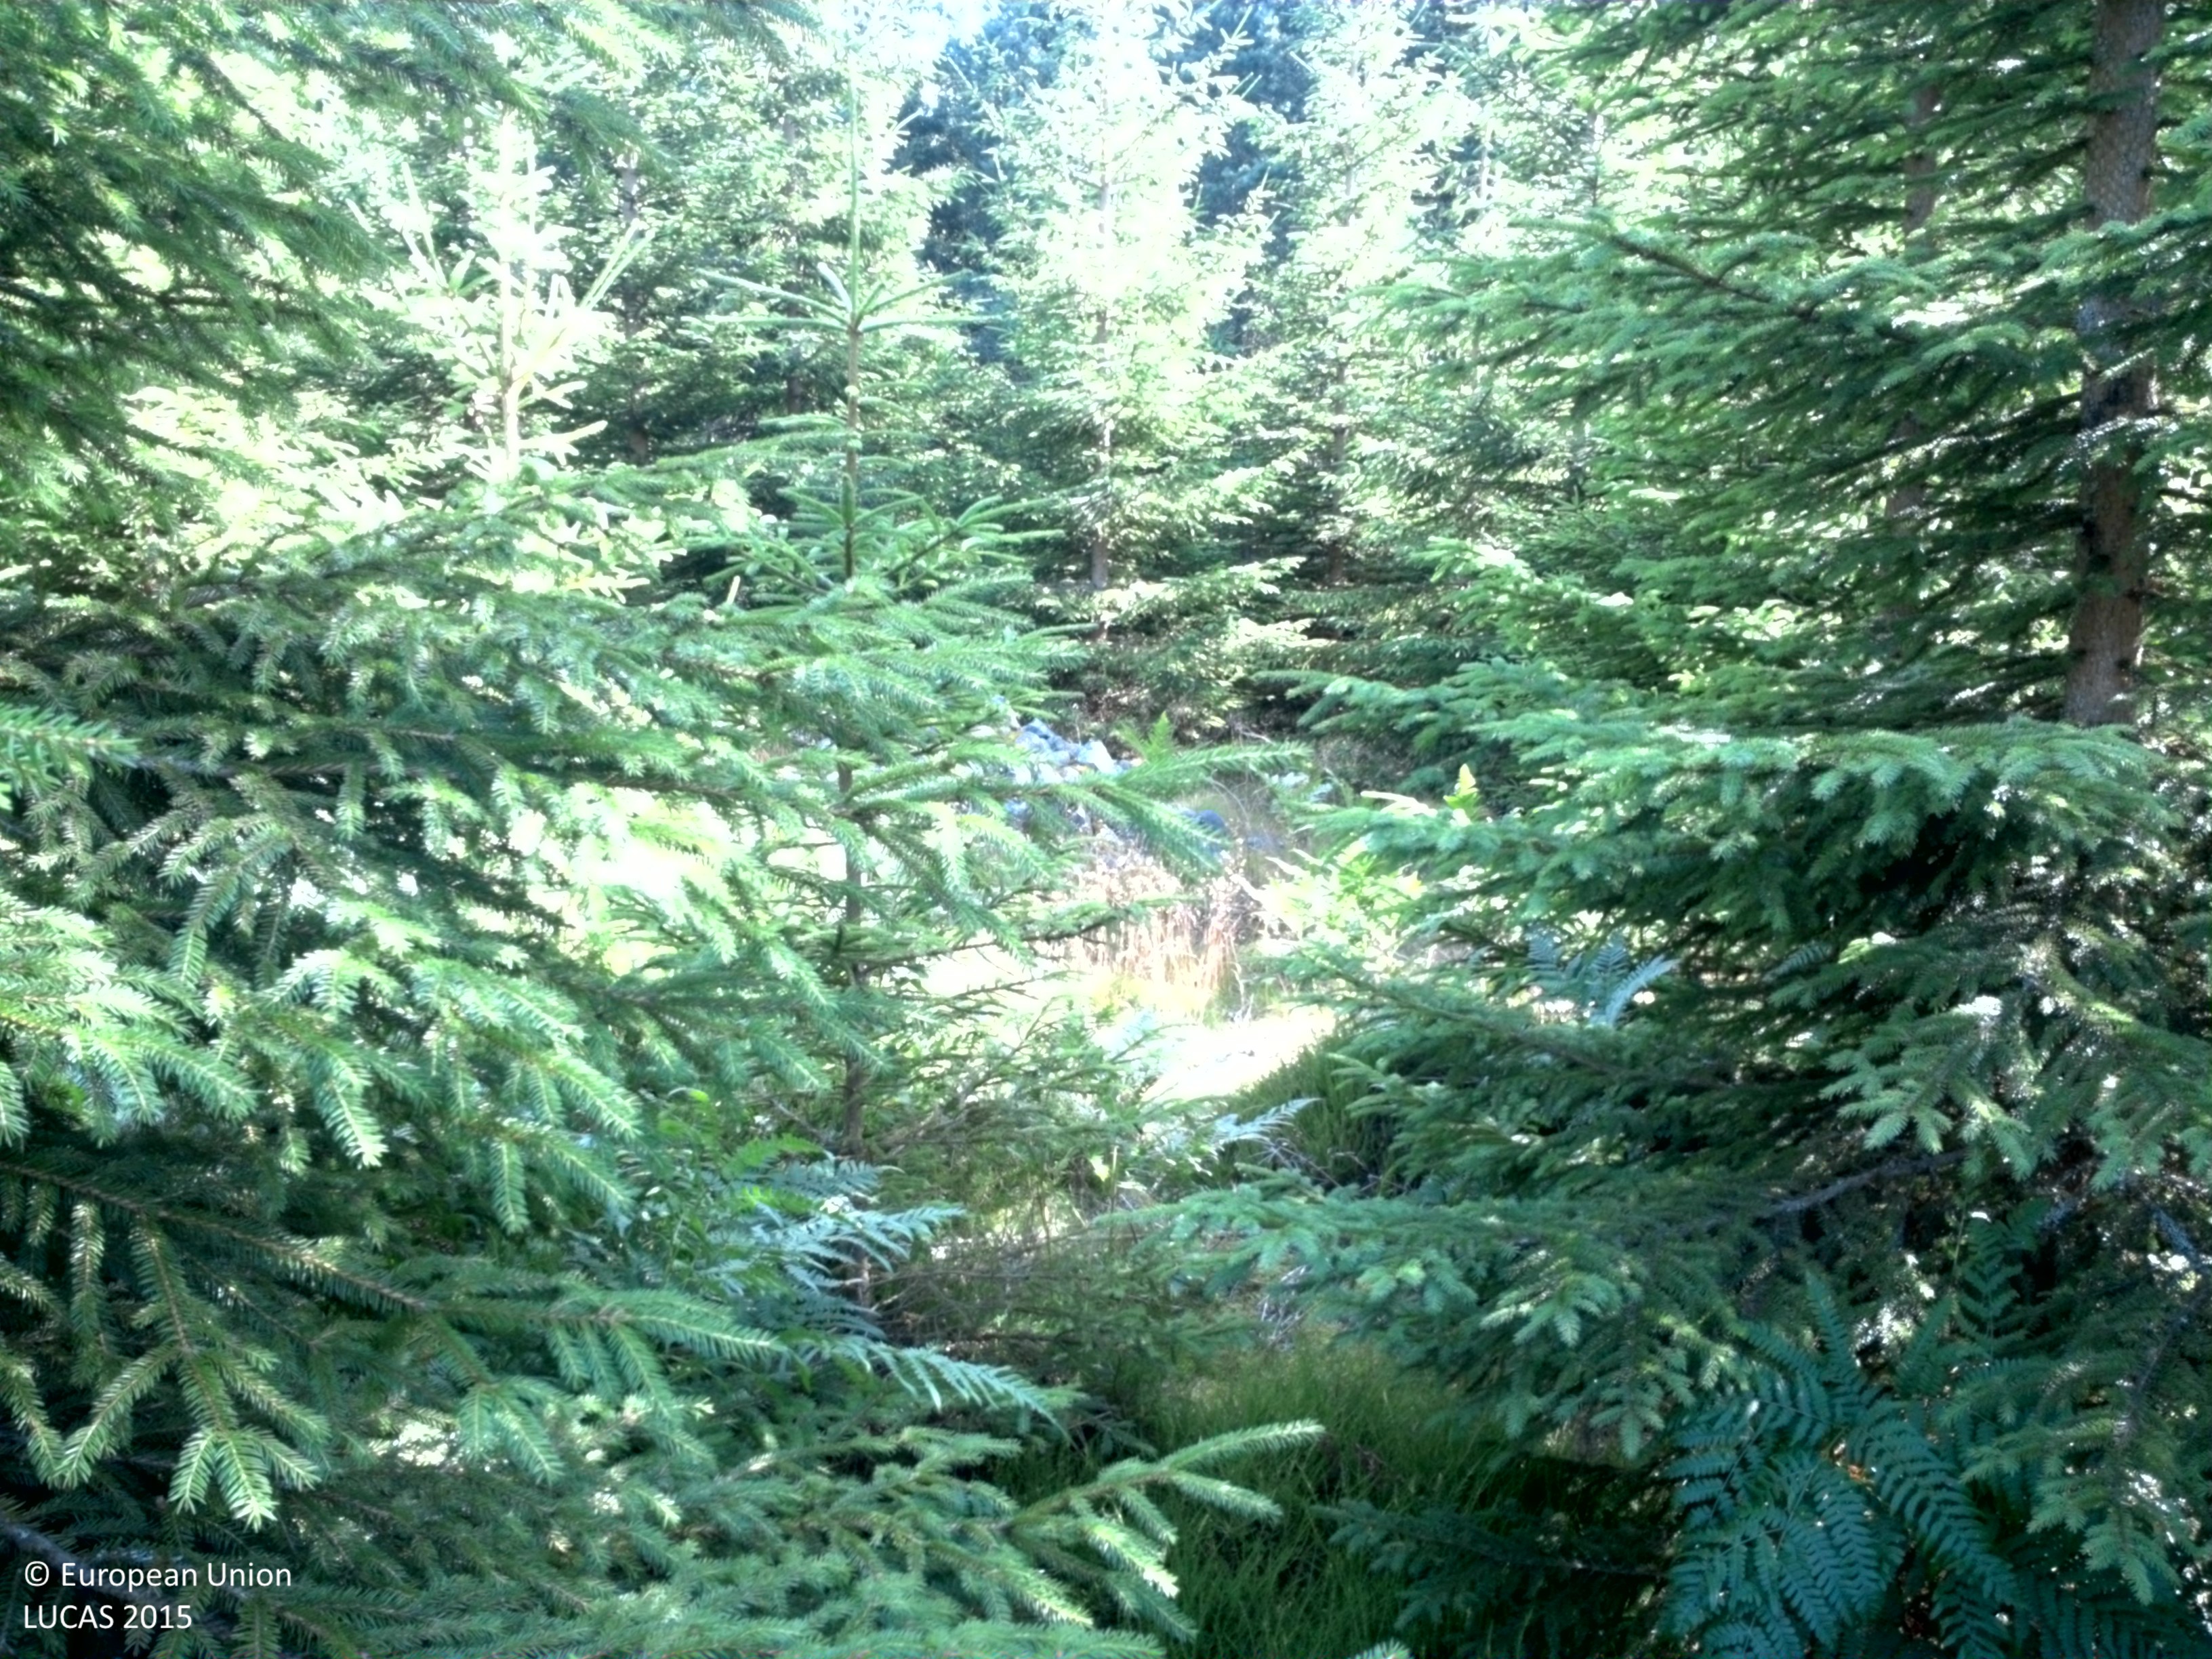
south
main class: Woodland
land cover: Spruce dominated coniferous woodland
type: boreal forest
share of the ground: 50 - 75 %
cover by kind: coniferous forest trees 50 %, lichens and mosses 30 %, herbaceous plants 20 %
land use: Forestry
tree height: < 5 m
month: August
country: SE
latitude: 58.1065
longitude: 13.9822
